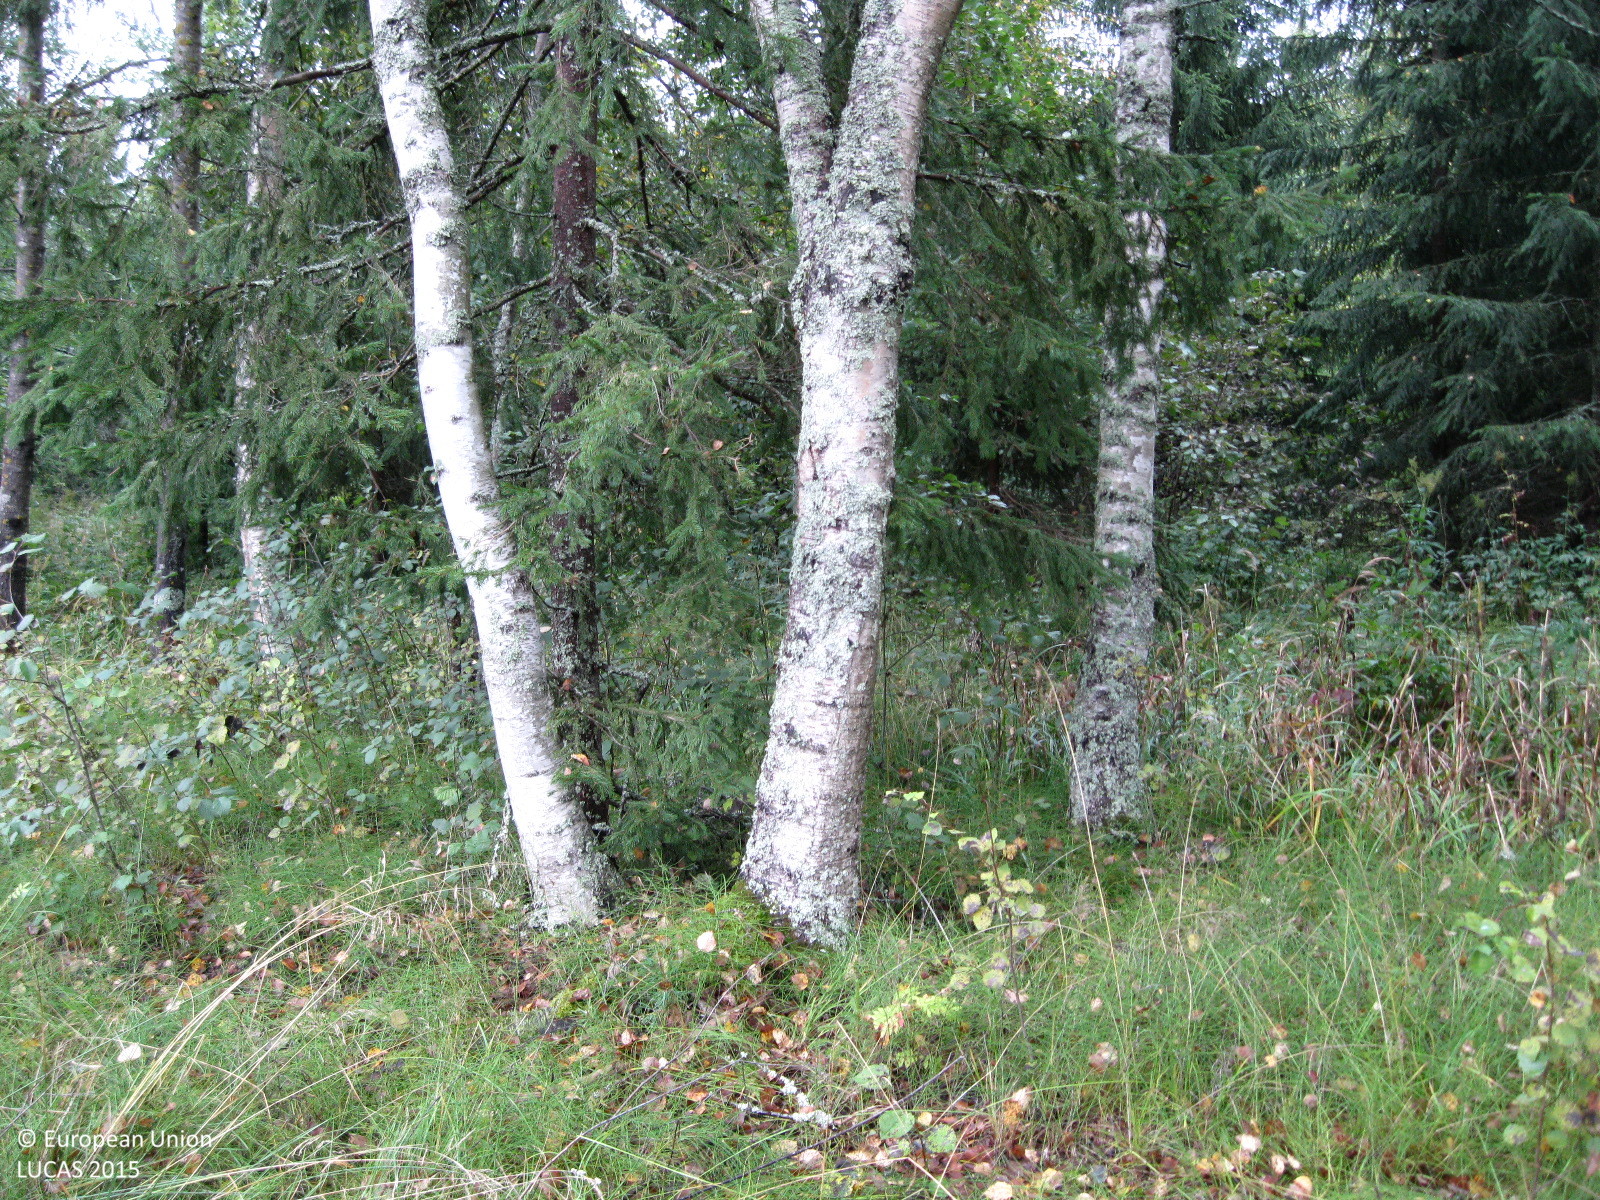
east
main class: Woodland
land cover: Broadleaved woodland
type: boreal forest
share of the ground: 50 - 75 %
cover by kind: broadleaved forest trees 50 %, herbaceous plants 45 %, coniferous forest trees 5 %
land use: Forestry
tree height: > 5 m
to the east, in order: Broadleaved woodland; Spruce dominated mixed woodland; Spruce dominated coniferous woodland; Rivers and streams; Spruce dominated coniferous woodland; Spruce dominated mixed woodland
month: September
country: FI
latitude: 60.4752
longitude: 24.6447
